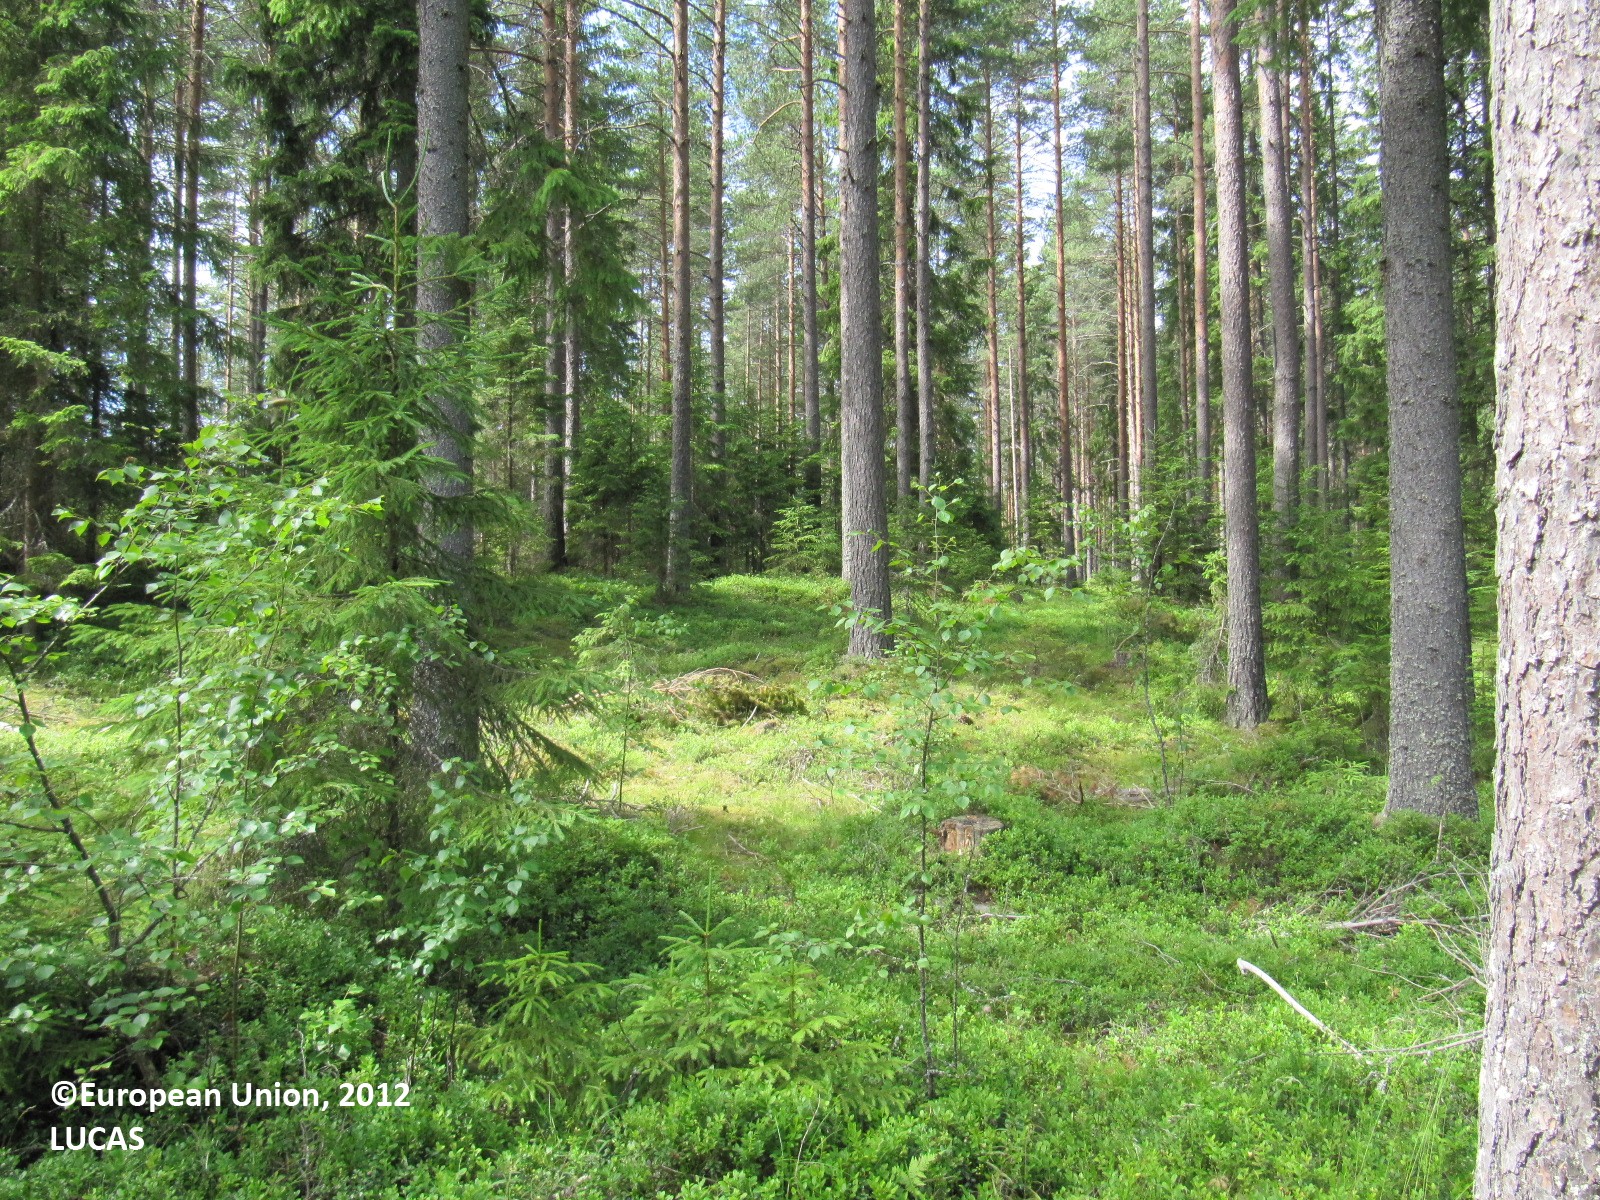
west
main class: Woodland
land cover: Other coniferous woodland
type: boreal forest
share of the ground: > 75 %
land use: Forestry
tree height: > 5 m
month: July
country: FI
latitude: 60.9864
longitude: 23.3702
